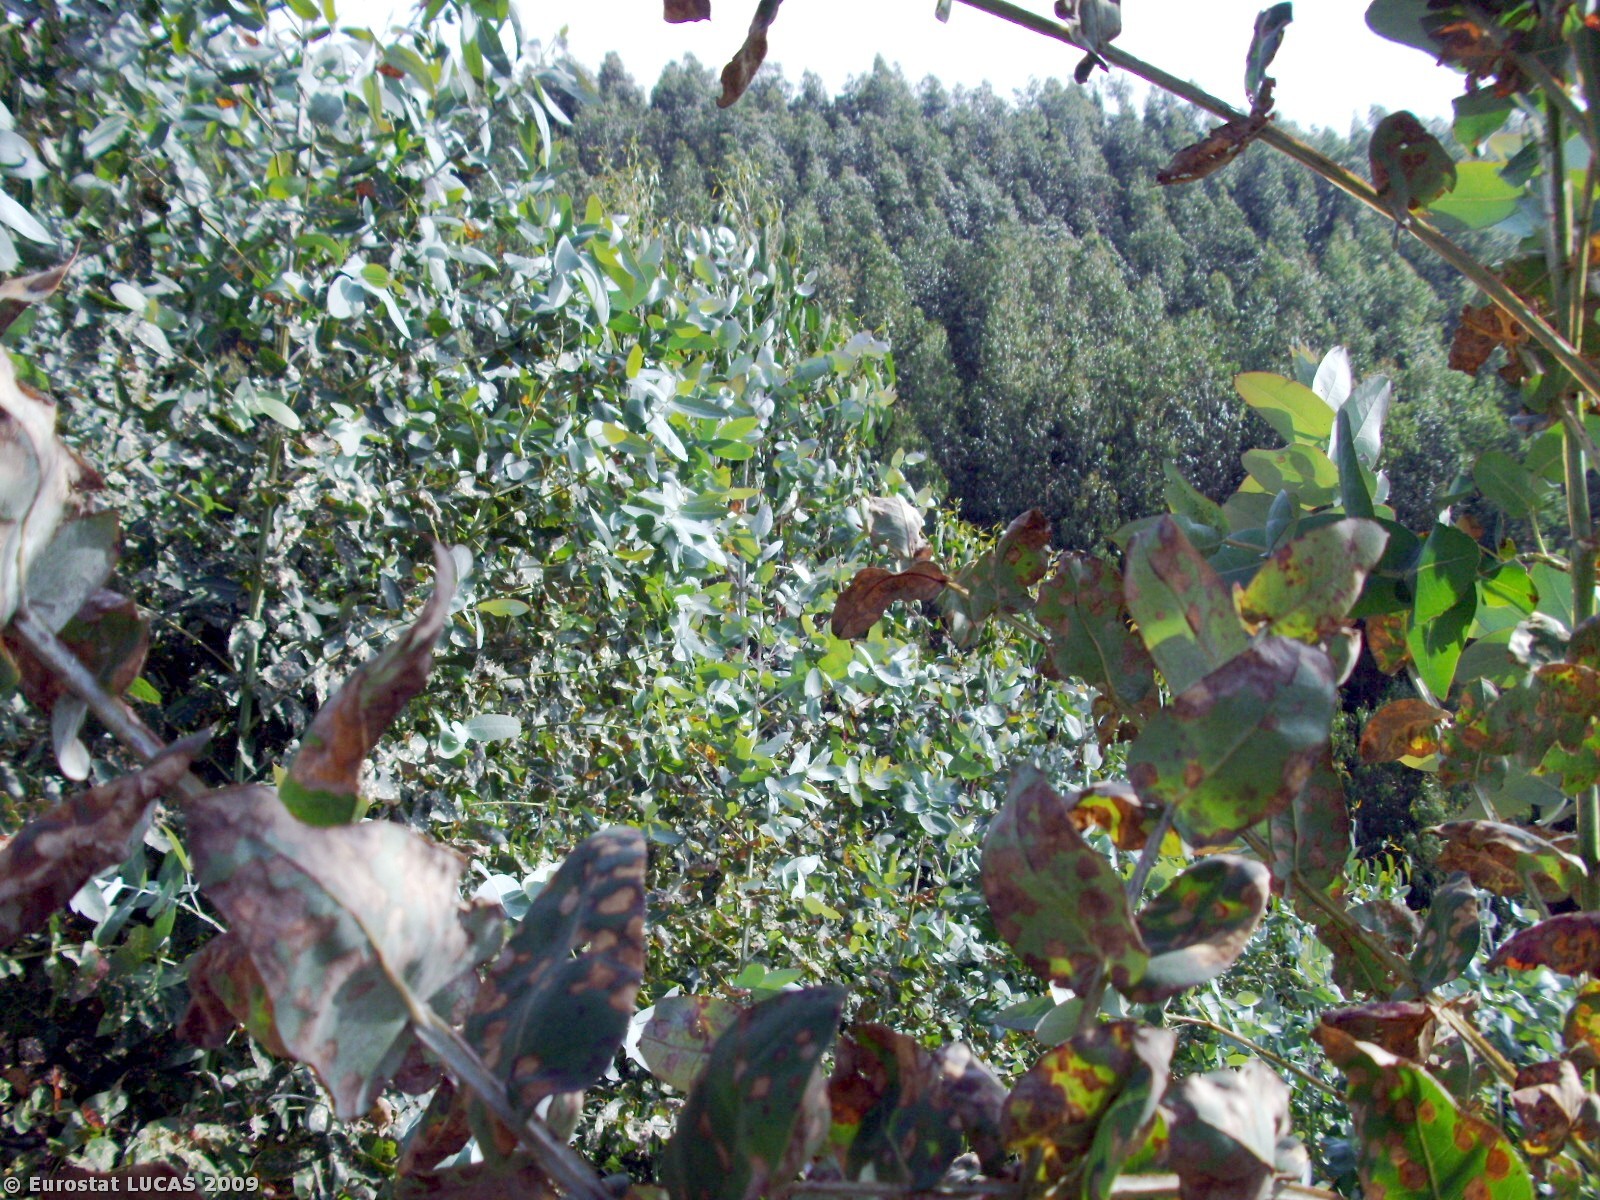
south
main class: Woodland
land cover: Broadleaved woodland
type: plantations and self-sown exotic forest
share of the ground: > 75 %
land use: Forestry
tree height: > 5 m
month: May
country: PT
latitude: 40.4609
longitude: -8.3531
